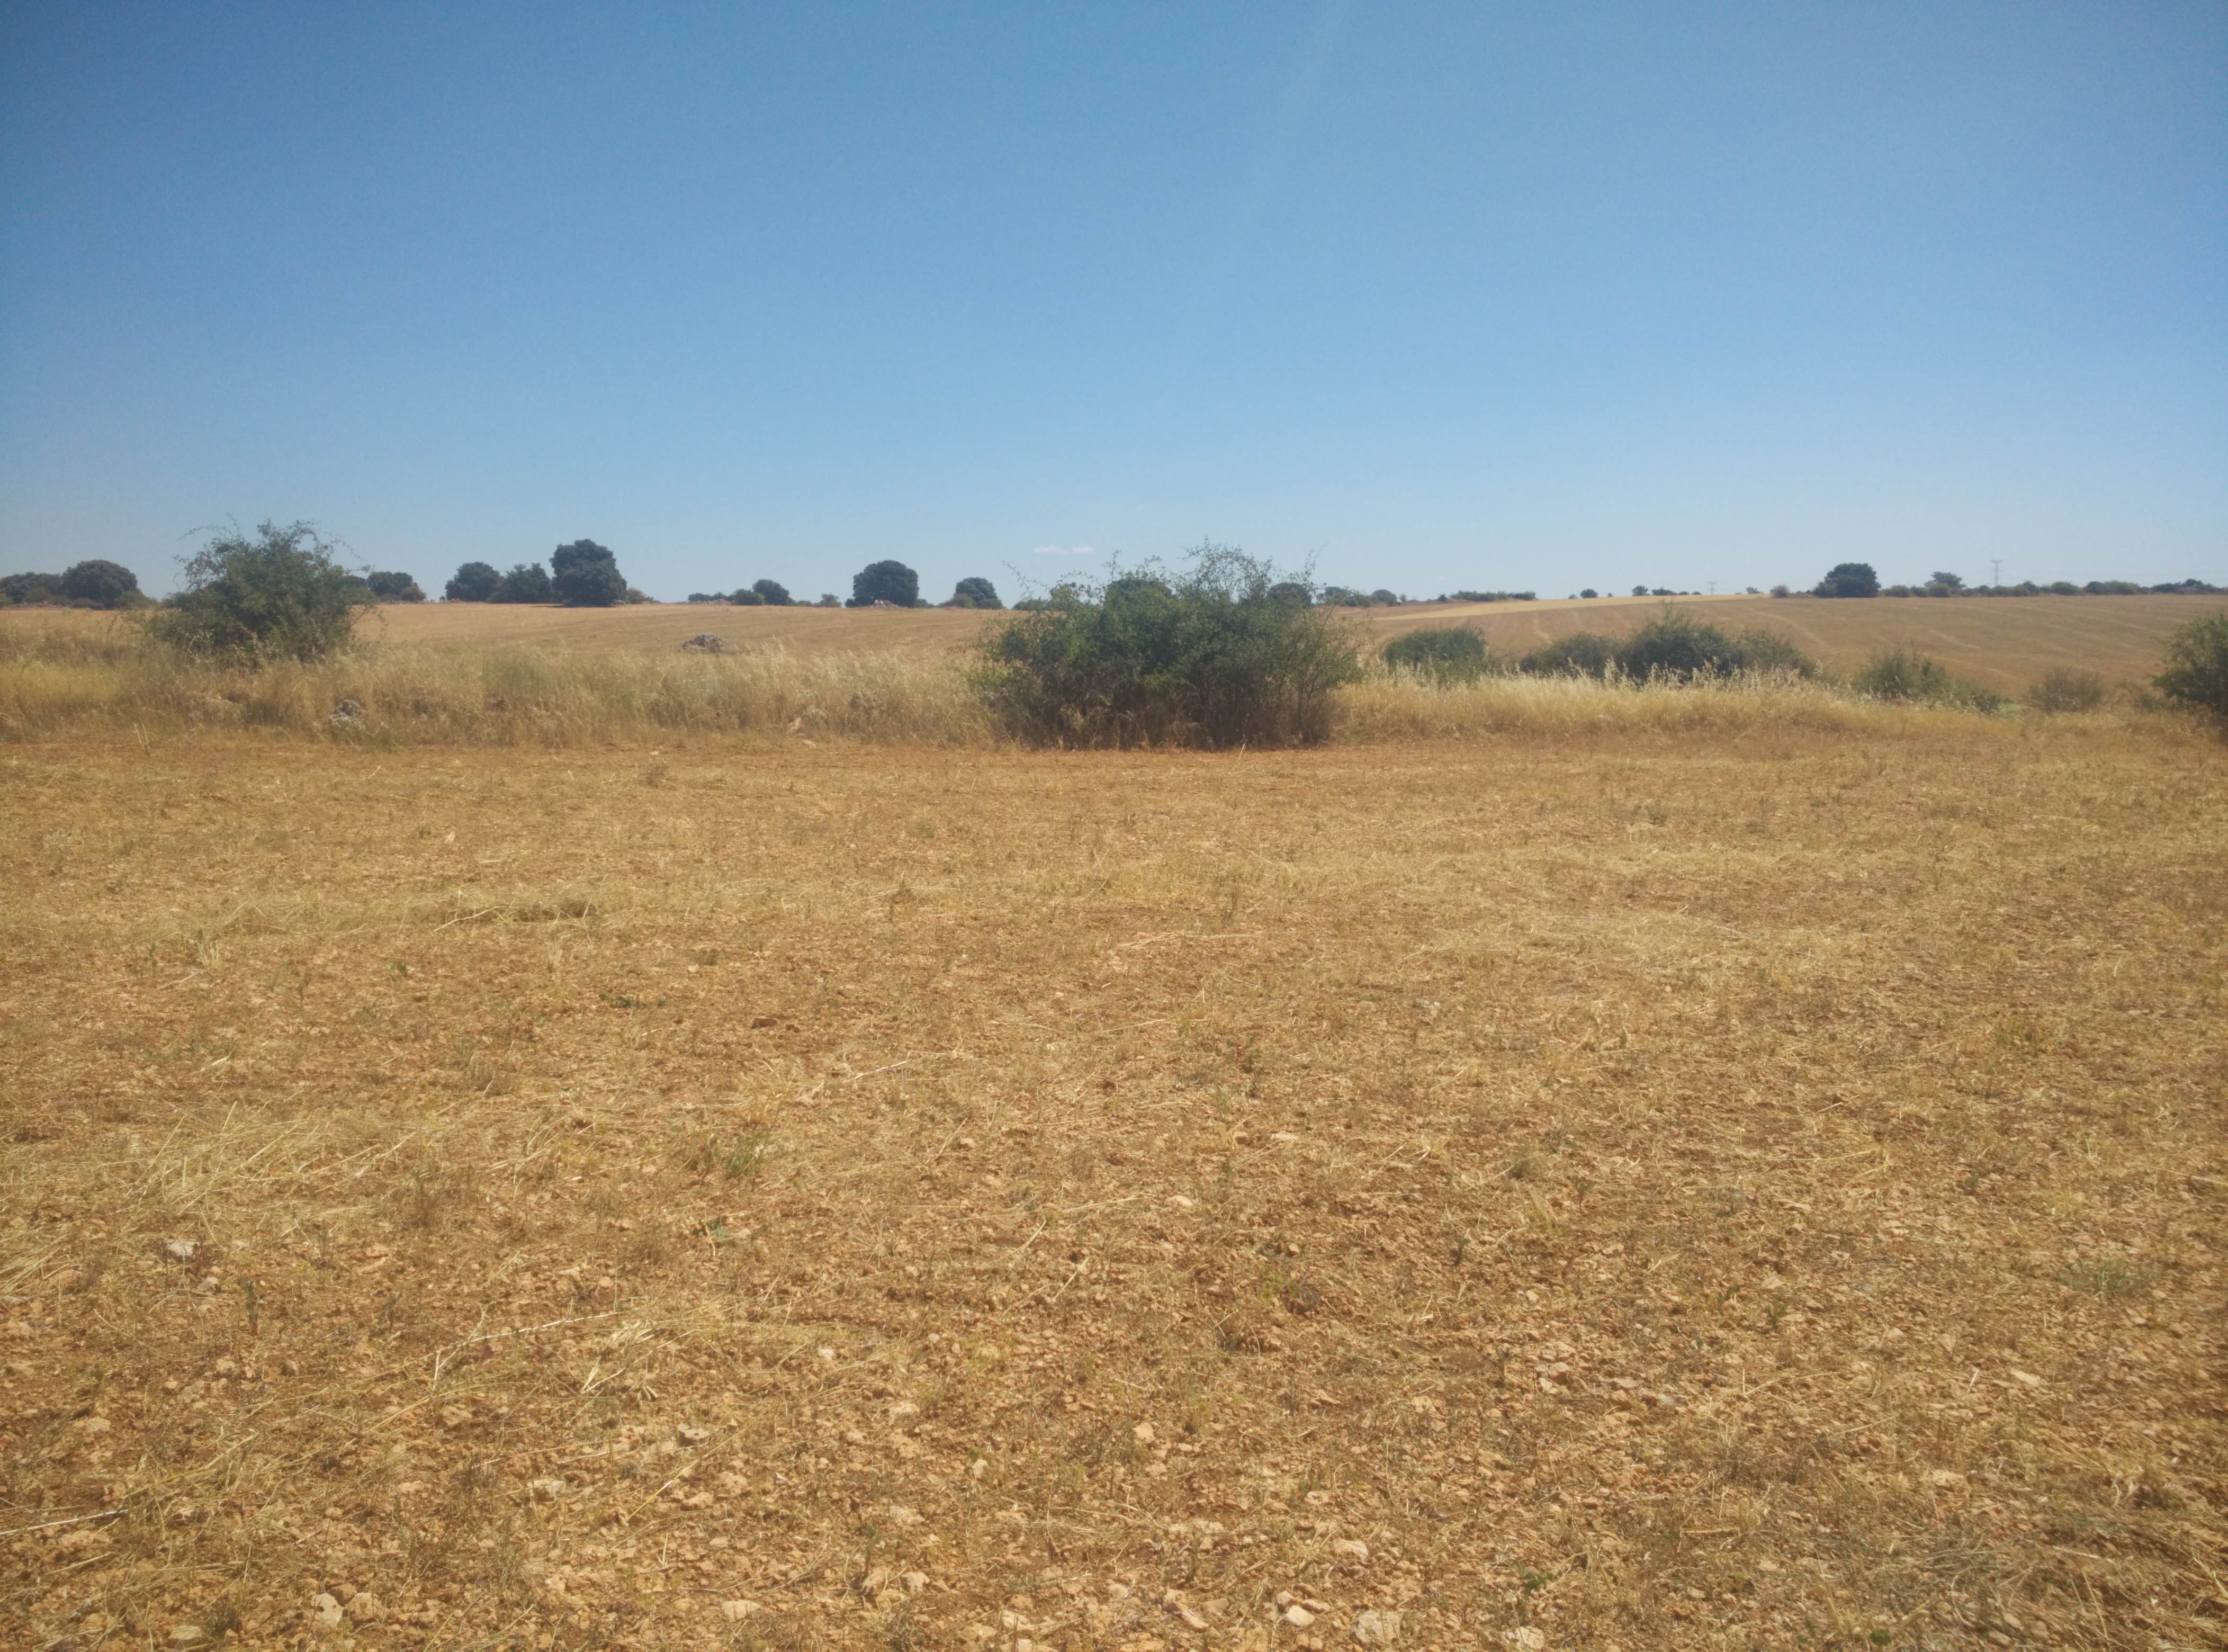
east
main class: Cropland
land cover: Common wheat
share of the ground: < 10 %
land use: Agriculture (excluding fallow land and kitchen gardens)
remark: Harvested field
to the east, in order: Common wheat; Shruby margins; Tracks; Grass margins; Dry pulses; Shrubland without tree cover; Dry pulses
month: July
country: ES
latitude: 40.6279
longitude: -2.8329
